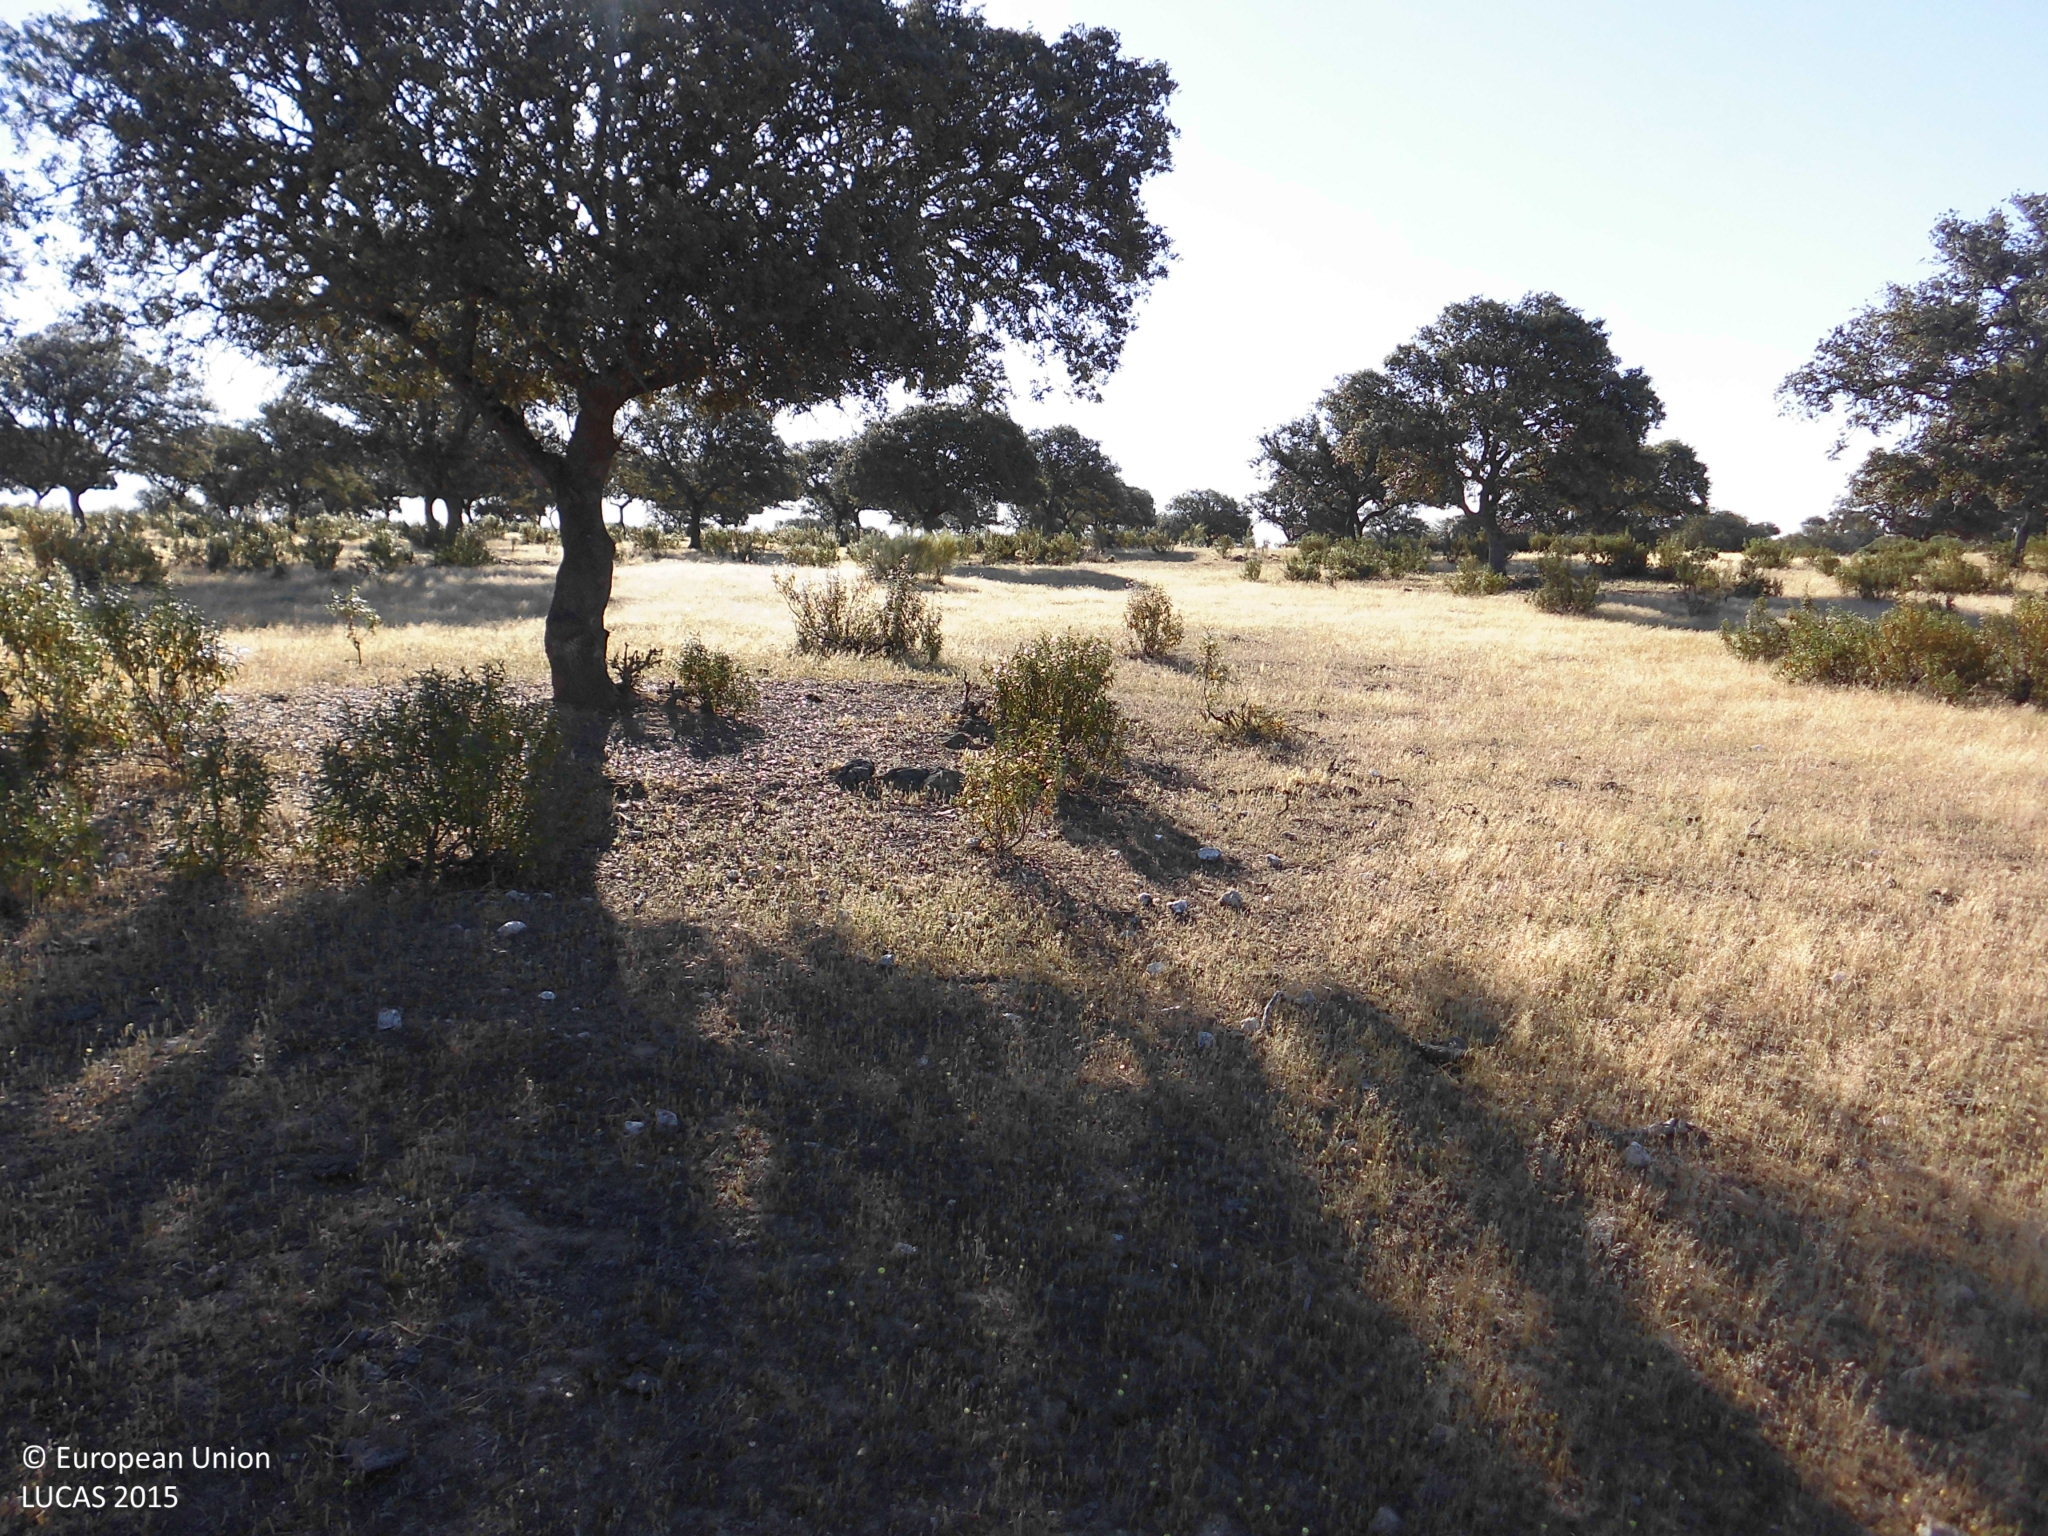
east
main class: Woodland
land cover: Broadleaved woodland
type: broadleaved evergreen forest
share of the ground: 10 - 25 %
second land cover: Grassland without tree/shrub cover
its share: > 75 %
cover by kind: herbaceous plants 50 %, broadleaved forest trees 25 %, shrubs 25 %
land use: Forestry
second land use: Agriculture (excluding fallow land and kitchen gardens)
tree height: > 5 m
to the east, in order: Broadleaved woodland; Grassland without tree/shrub cover; Tracks; Broadleaved woodland; Tracks; Broadleaved woodland
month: May
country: ES
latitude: 39.5083
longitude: -7.0041
